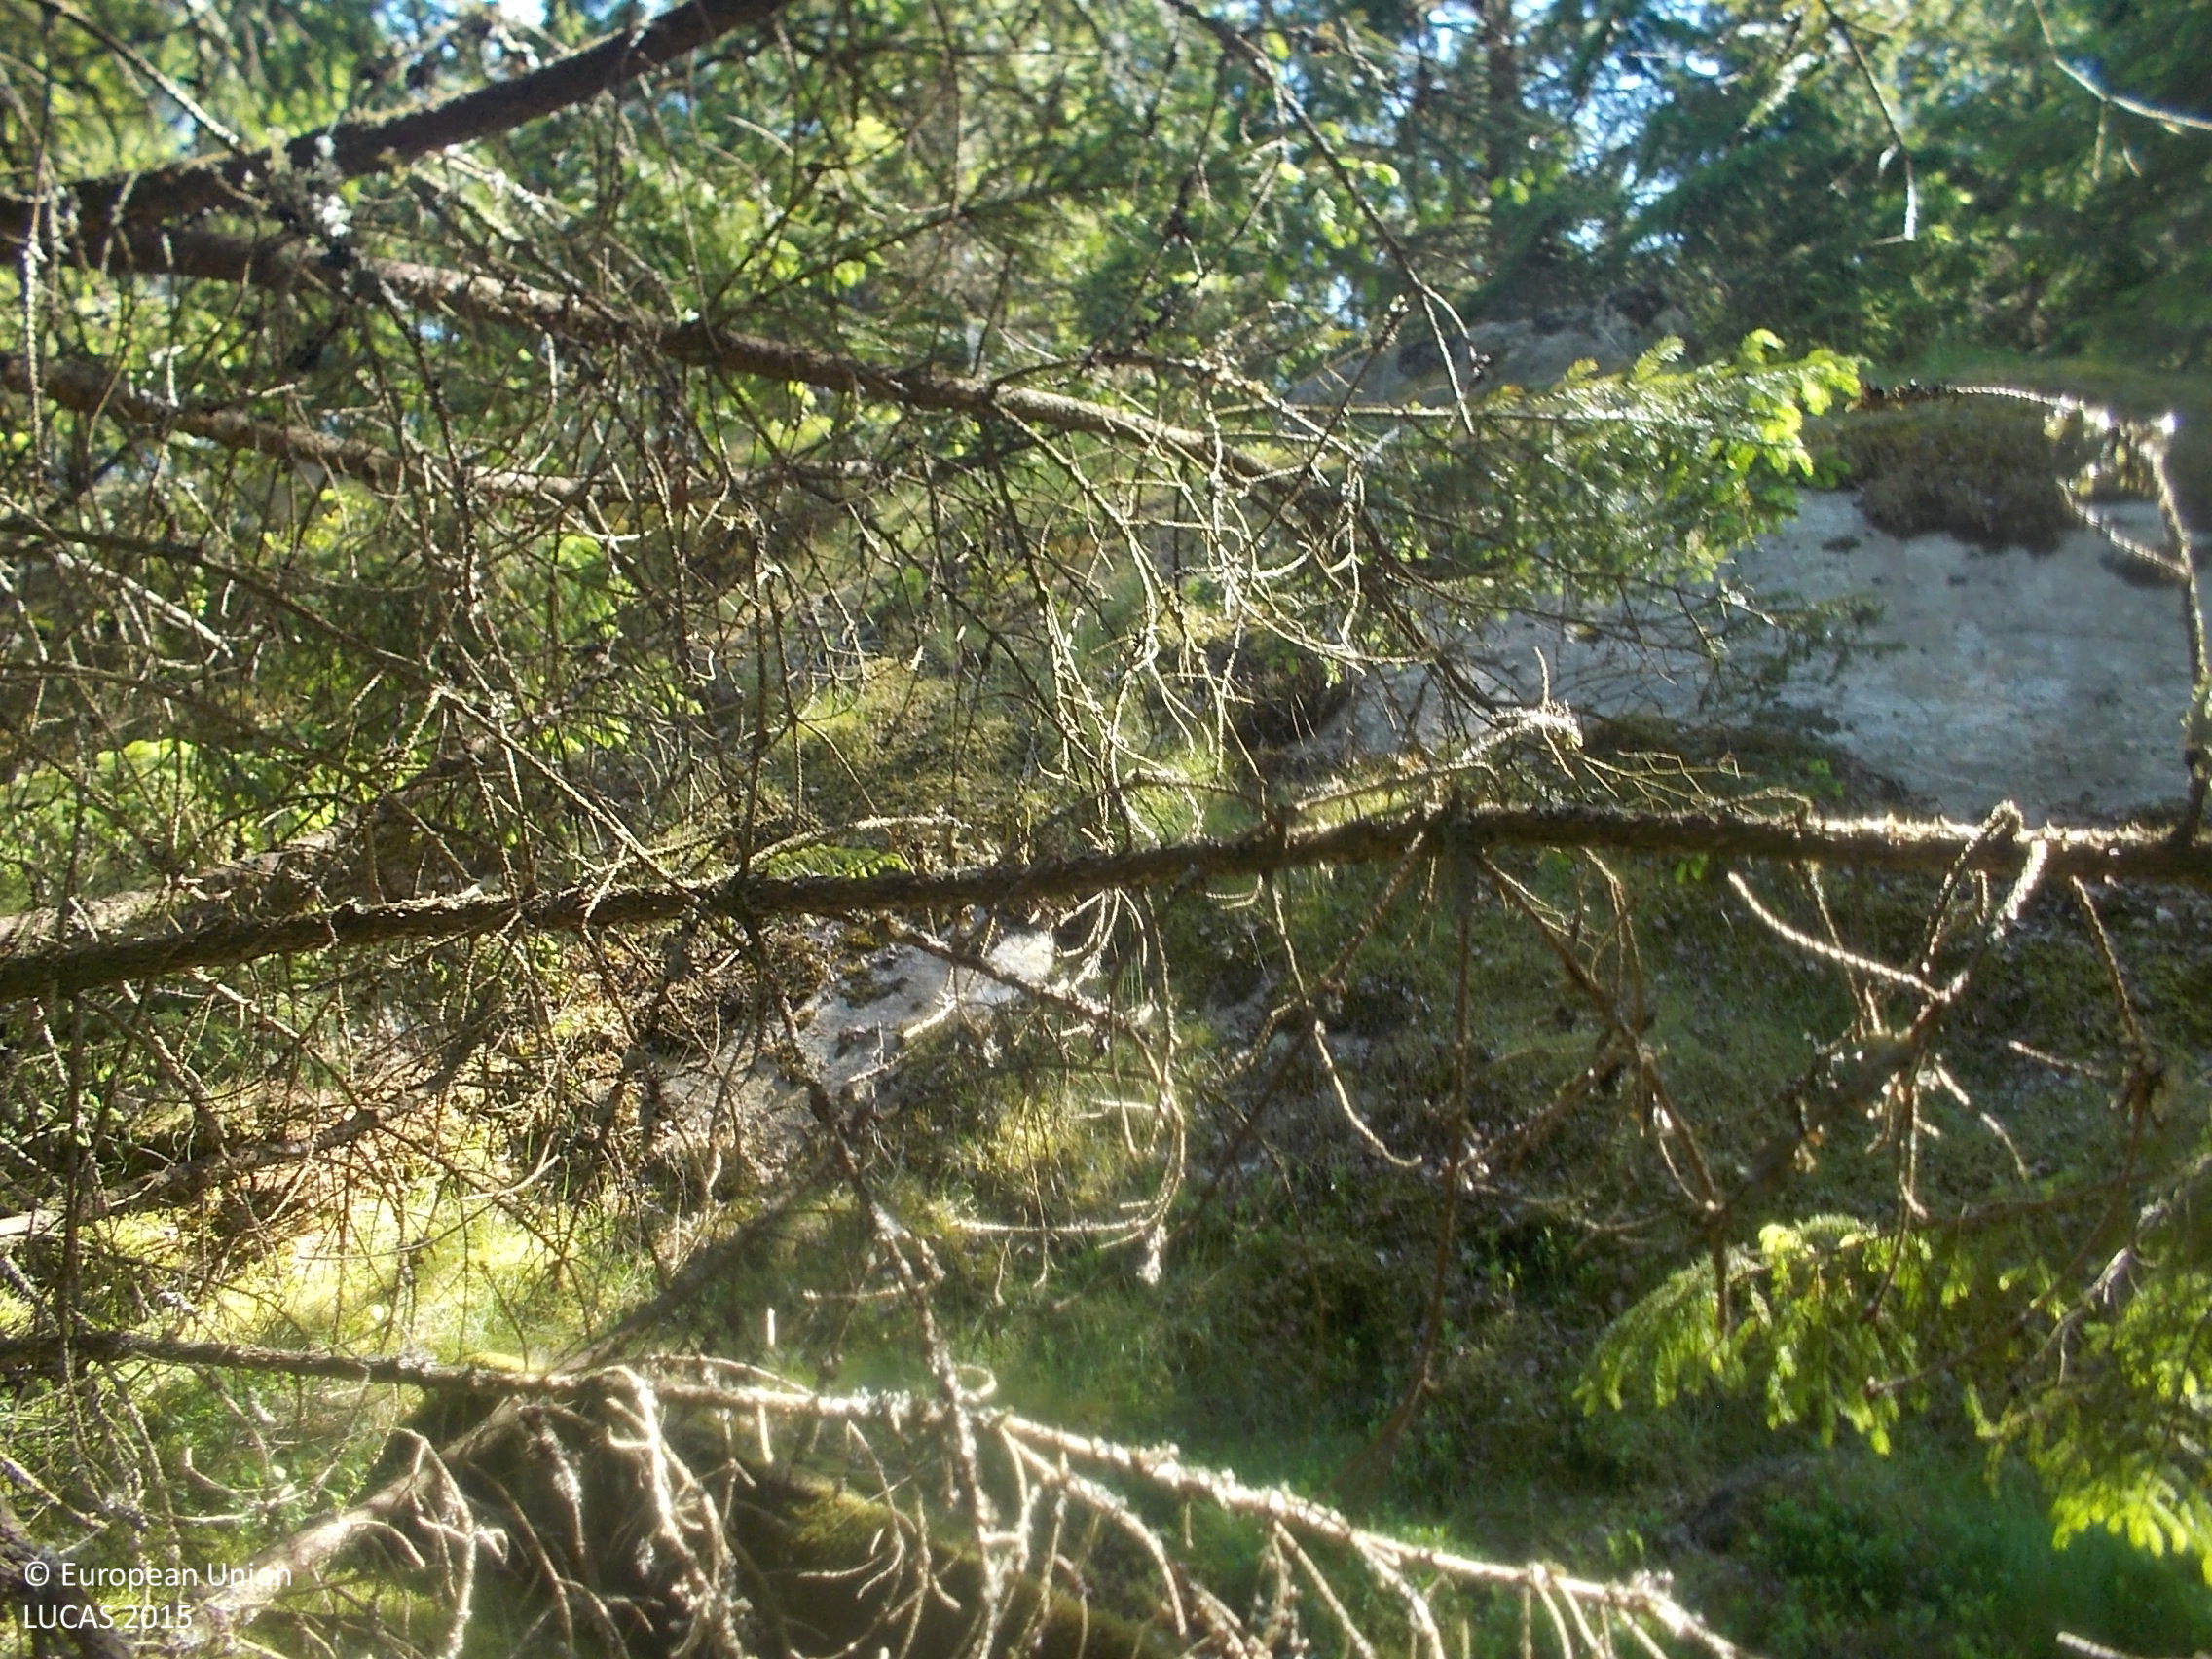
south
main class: Woodland
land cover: Spruce dominated coniferous woodland
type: boreal forest
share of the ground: > 75 %
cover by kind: coniferous forest trees 75 %, lichens and mosses 15 %, unconsolidated bare surface 10 %
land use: Forestry
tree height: > 5 m
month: July
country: SE
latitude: 57.2995
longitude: 13.1991
